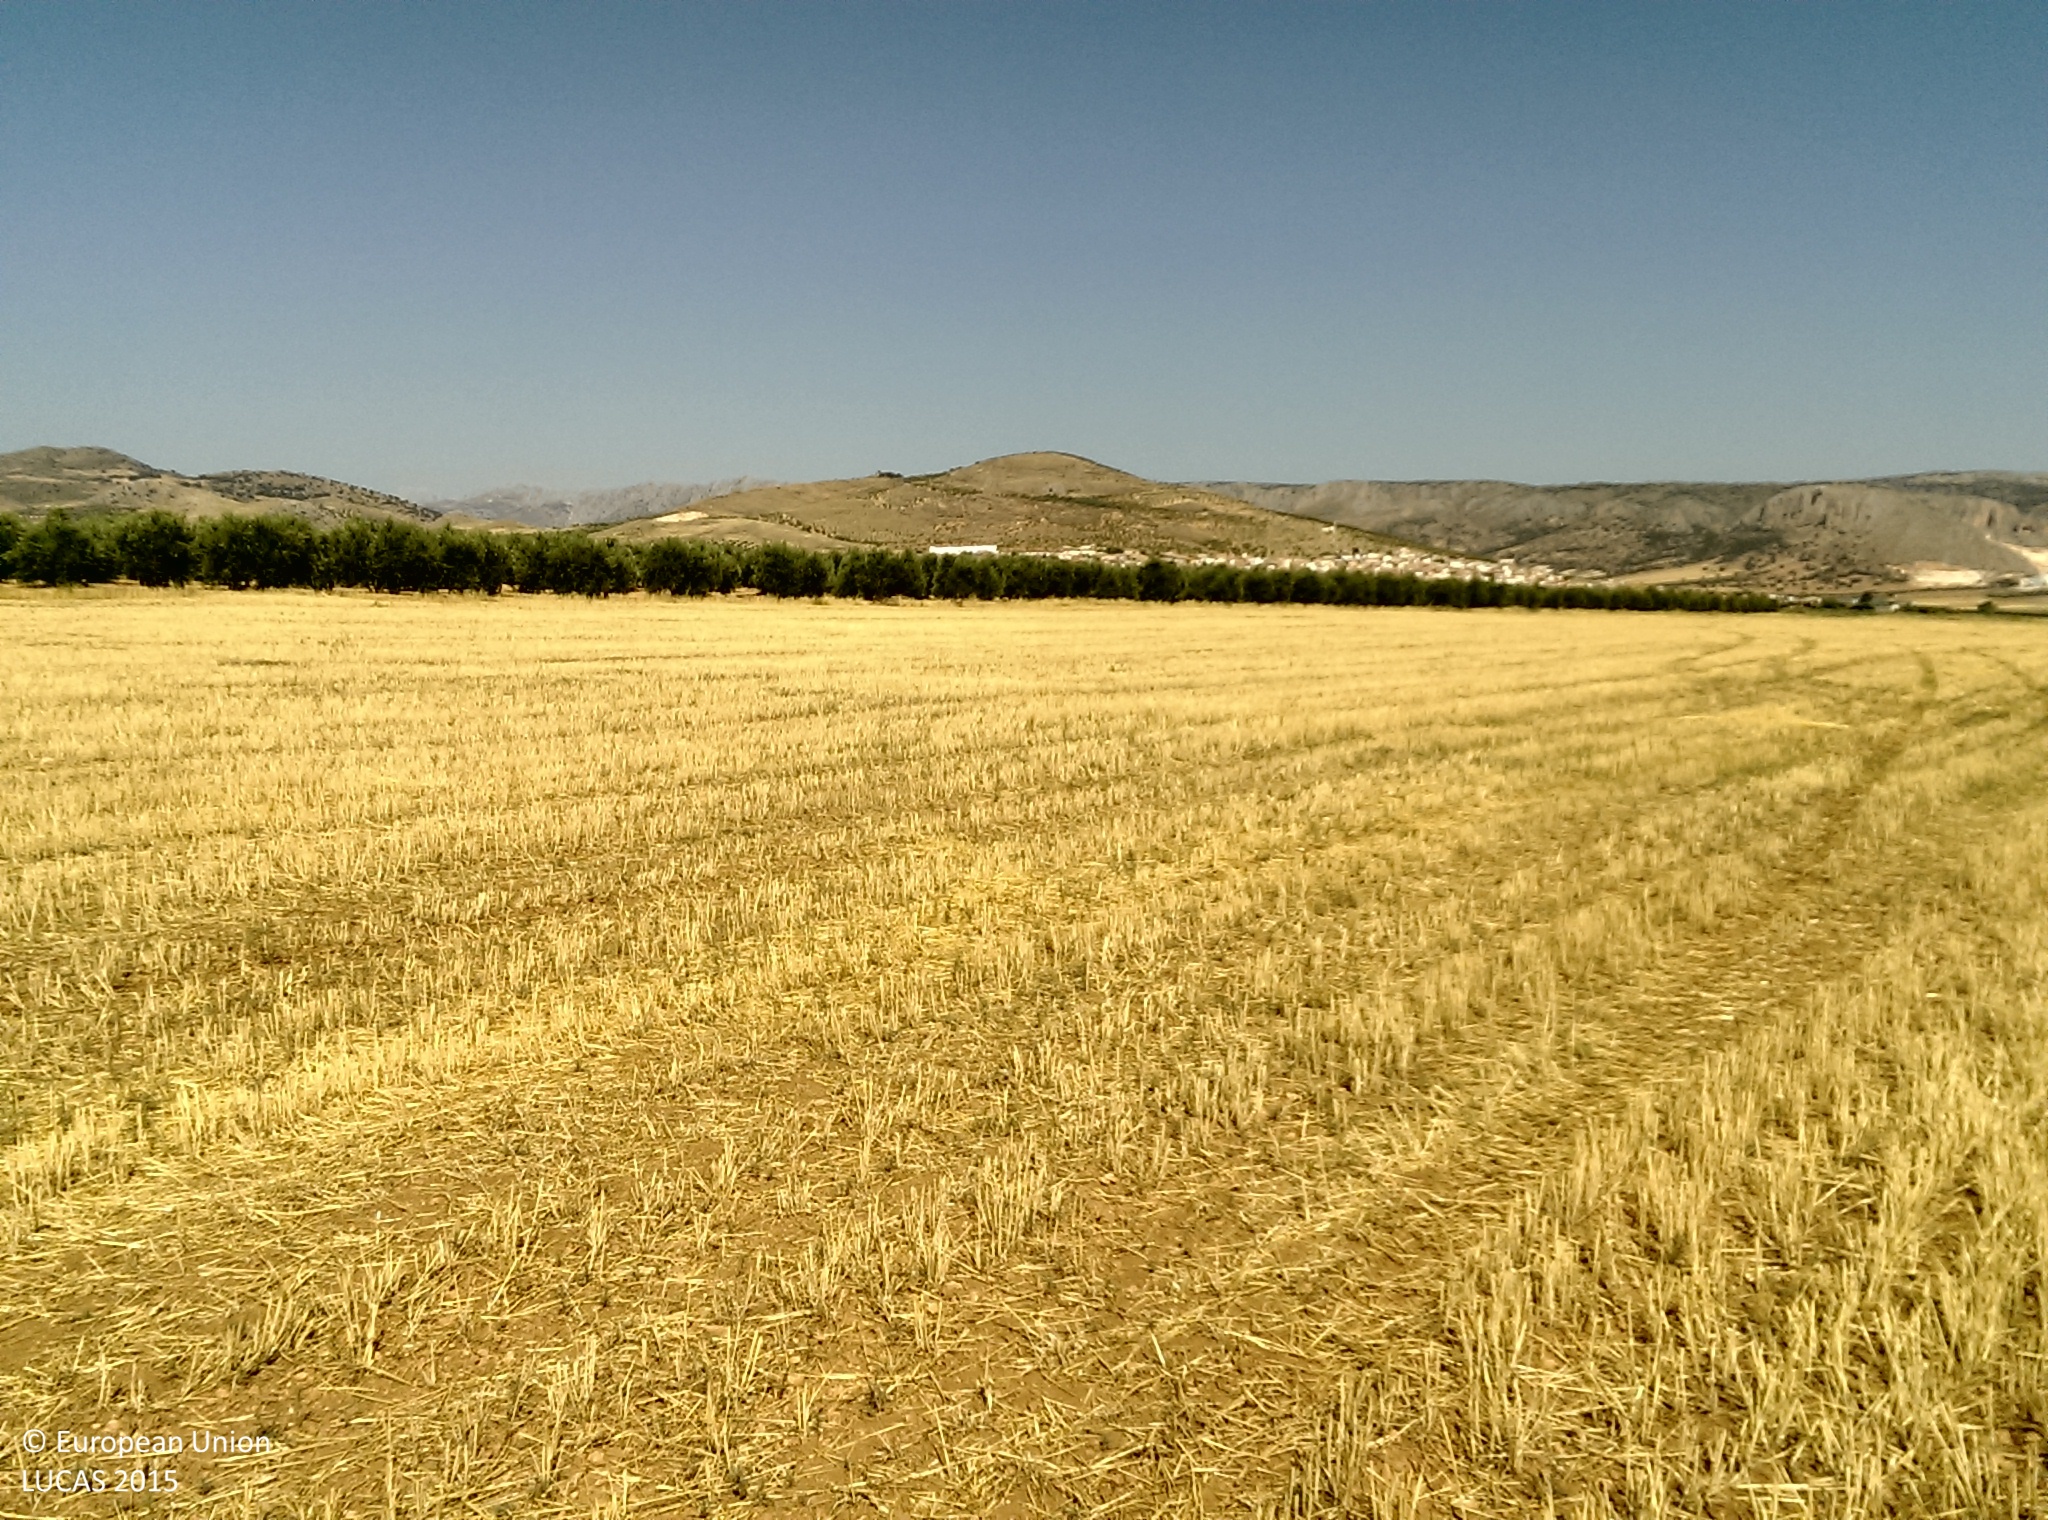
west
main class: Cropland
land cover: Barley
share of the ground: < 10 %
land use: Agriculture (excluding fallow land and kitchen gardens)
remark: Harvested field
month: July
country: ES
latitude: 37.3446
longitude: -3.2751
